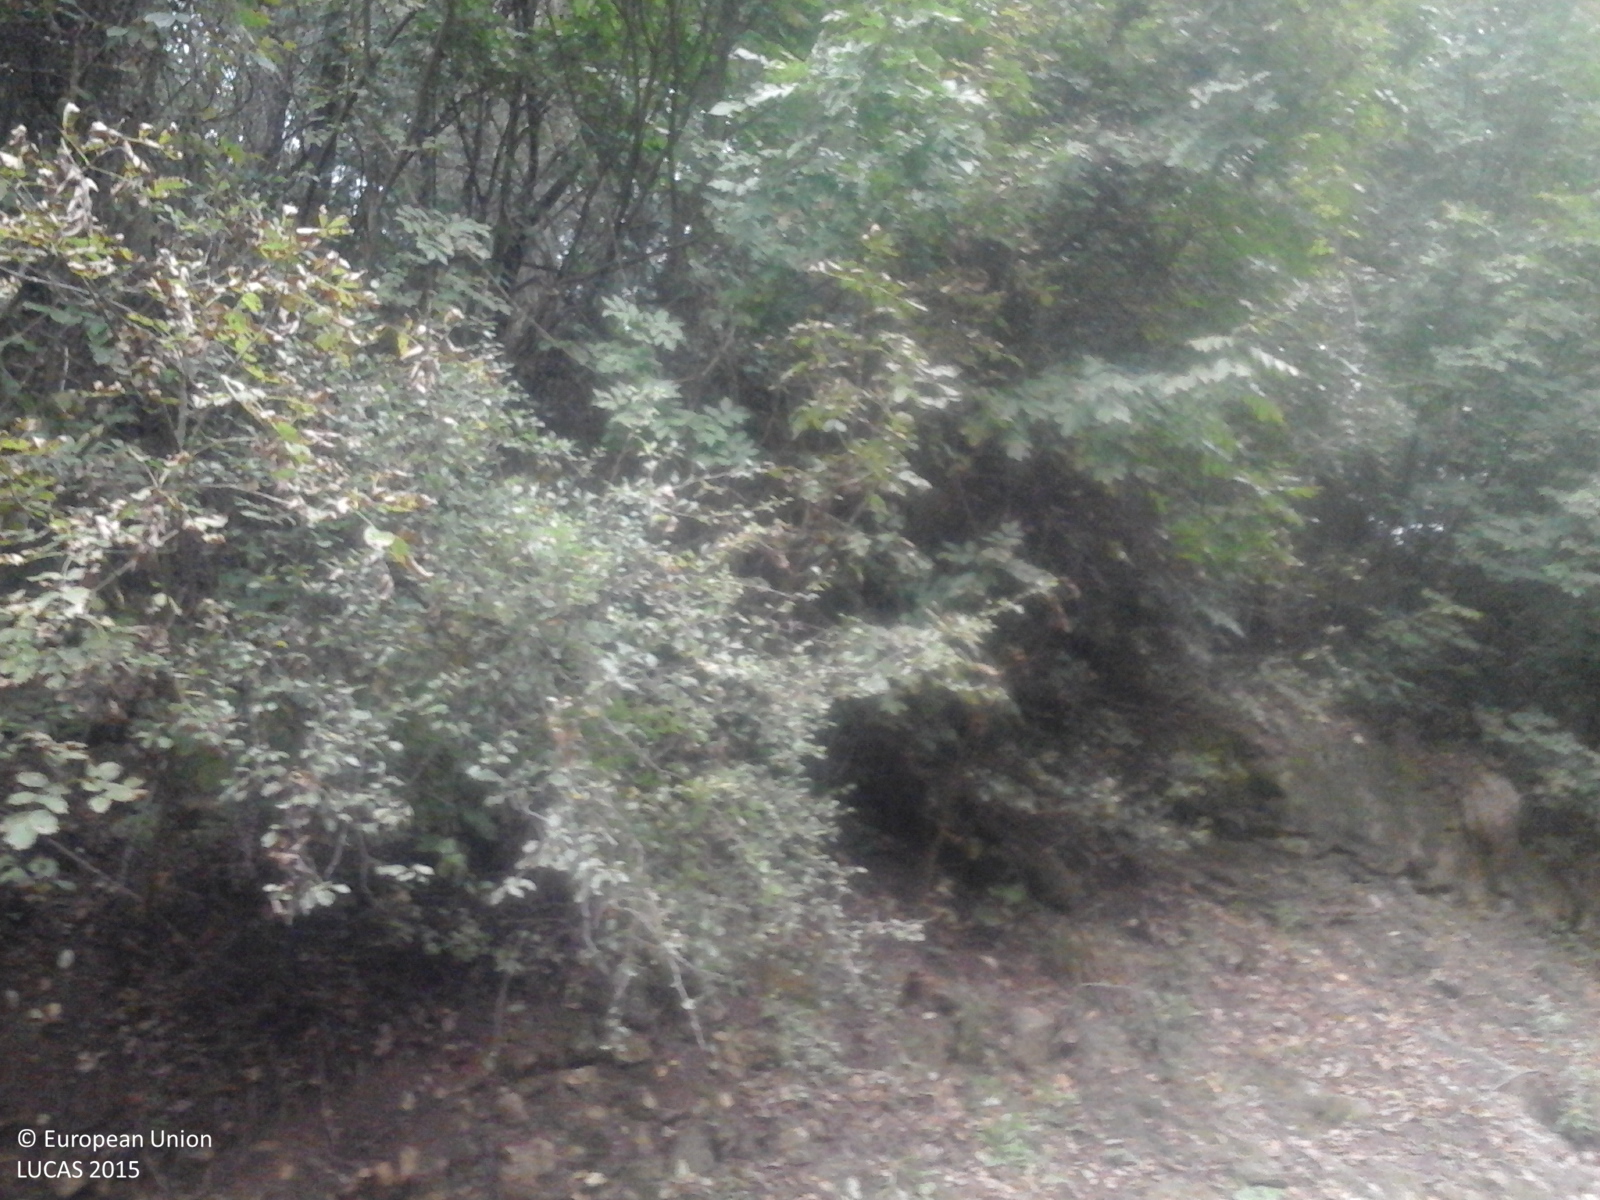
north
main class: Grassland
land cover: Grassland without tree/shrub cover
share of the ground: > 75 %
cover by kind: herbaceous plants 100 %
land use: Agriculture (excluding fallow land and kitchen gardens)
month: October
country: RO
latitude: 45.9994
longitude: 23.3749
